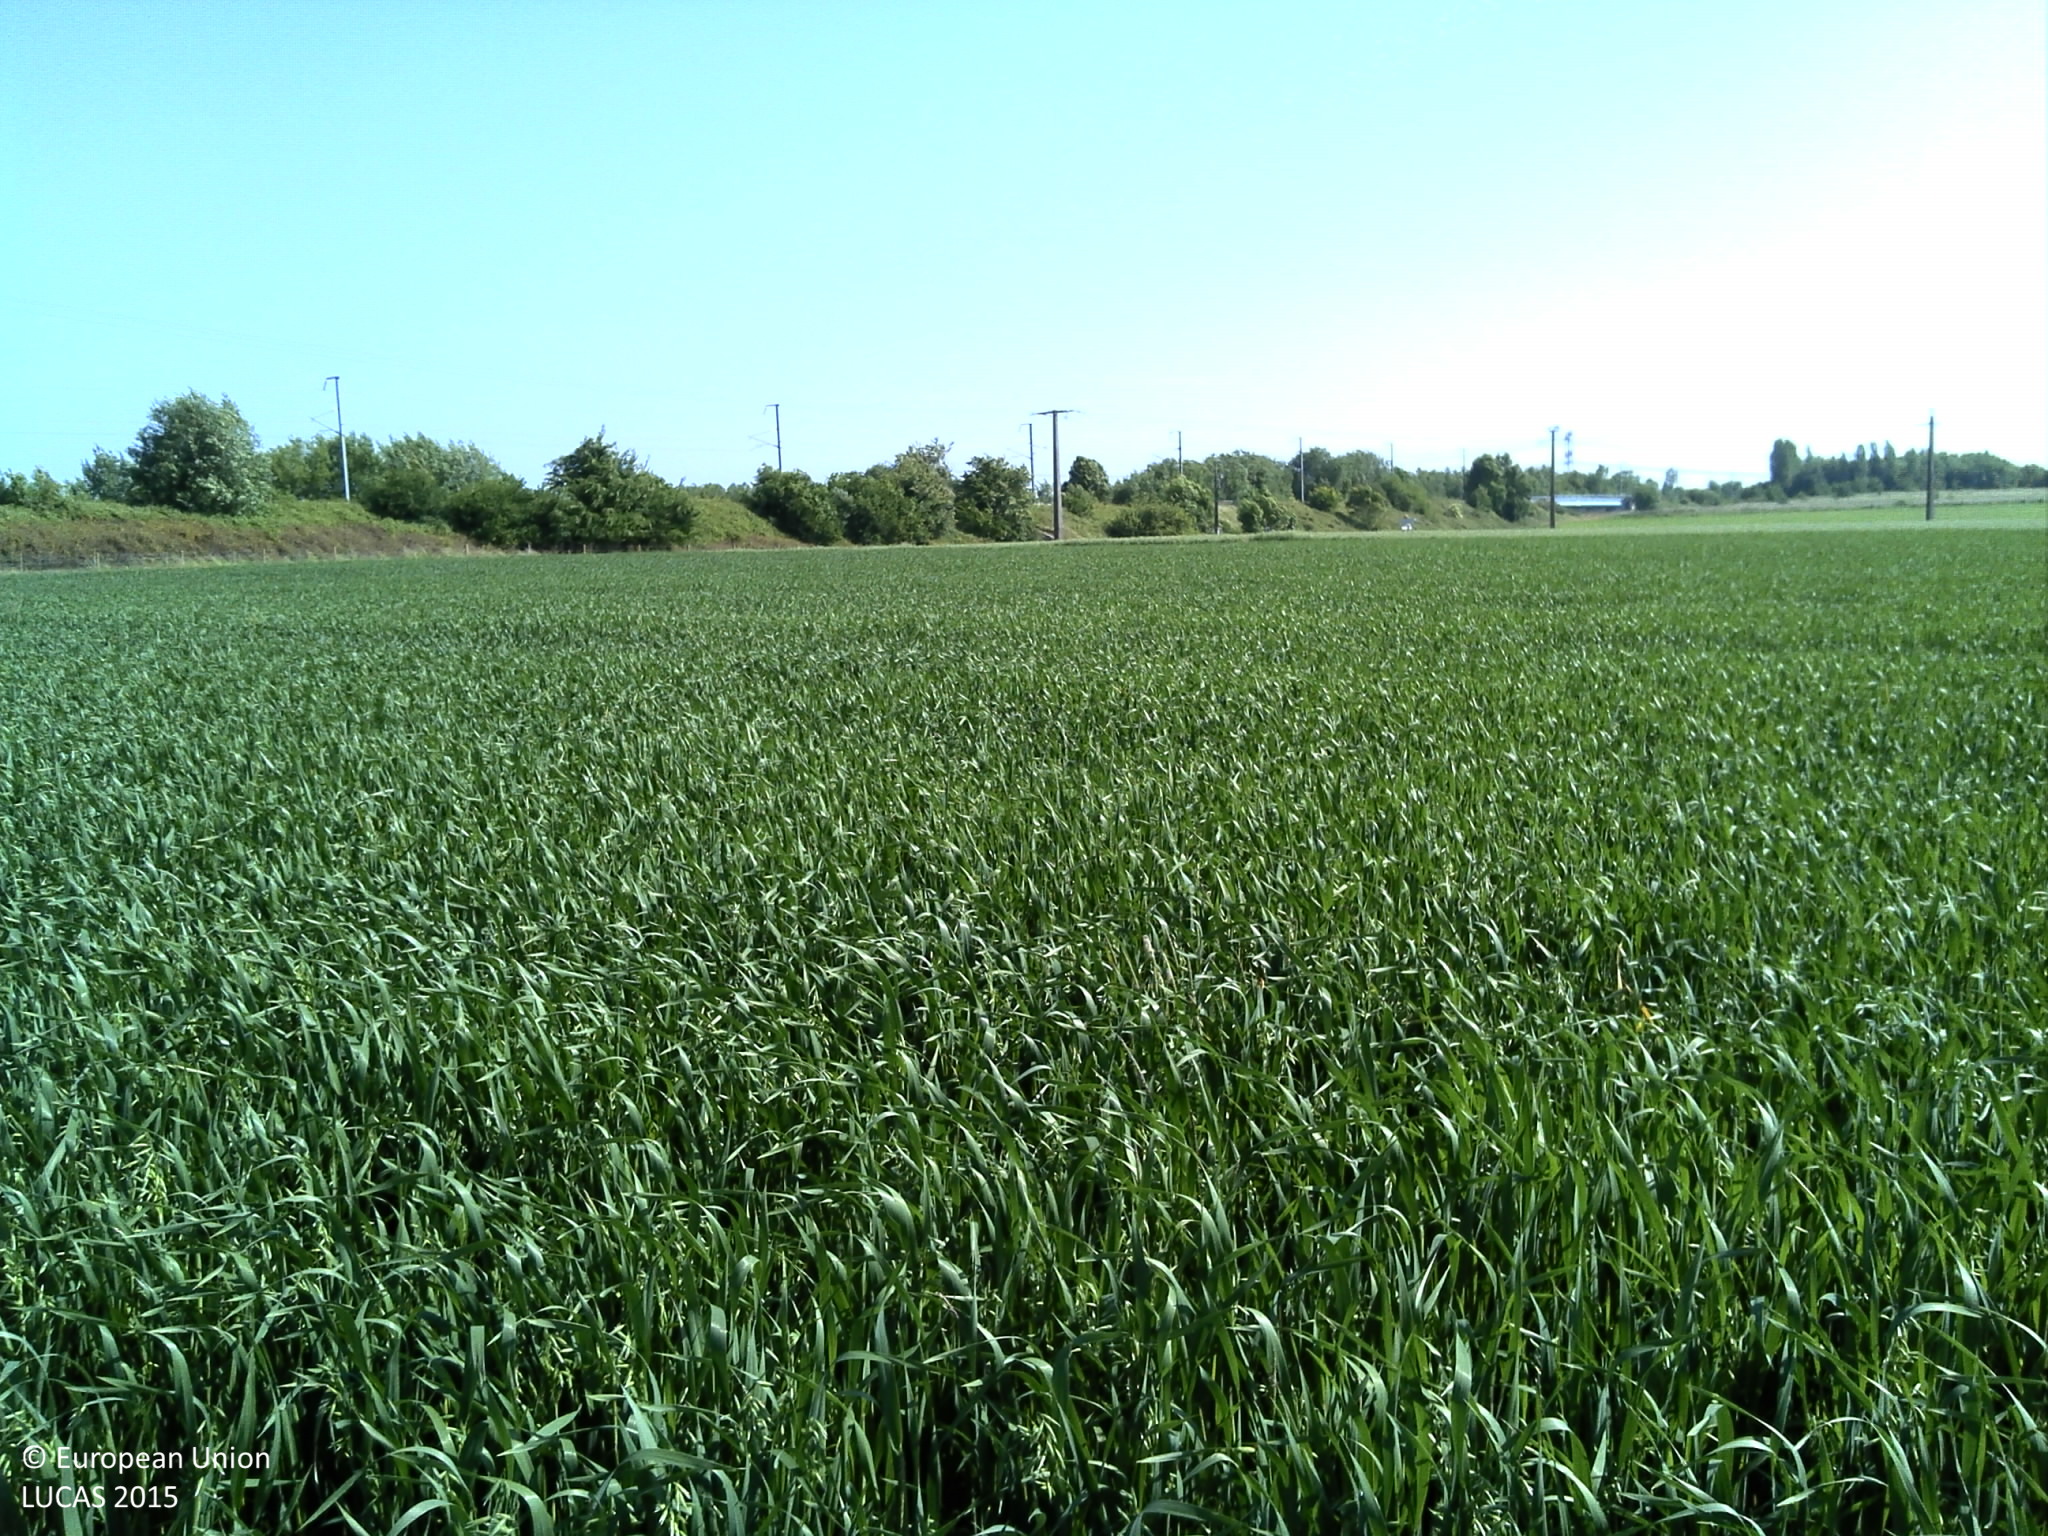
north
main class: Cropland
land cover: Oats
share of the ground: > 75 %
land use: Agriculture (excluding fallow land and kitchen gardens)
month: June
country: FR
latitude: 49.6346
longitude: 1.0751
